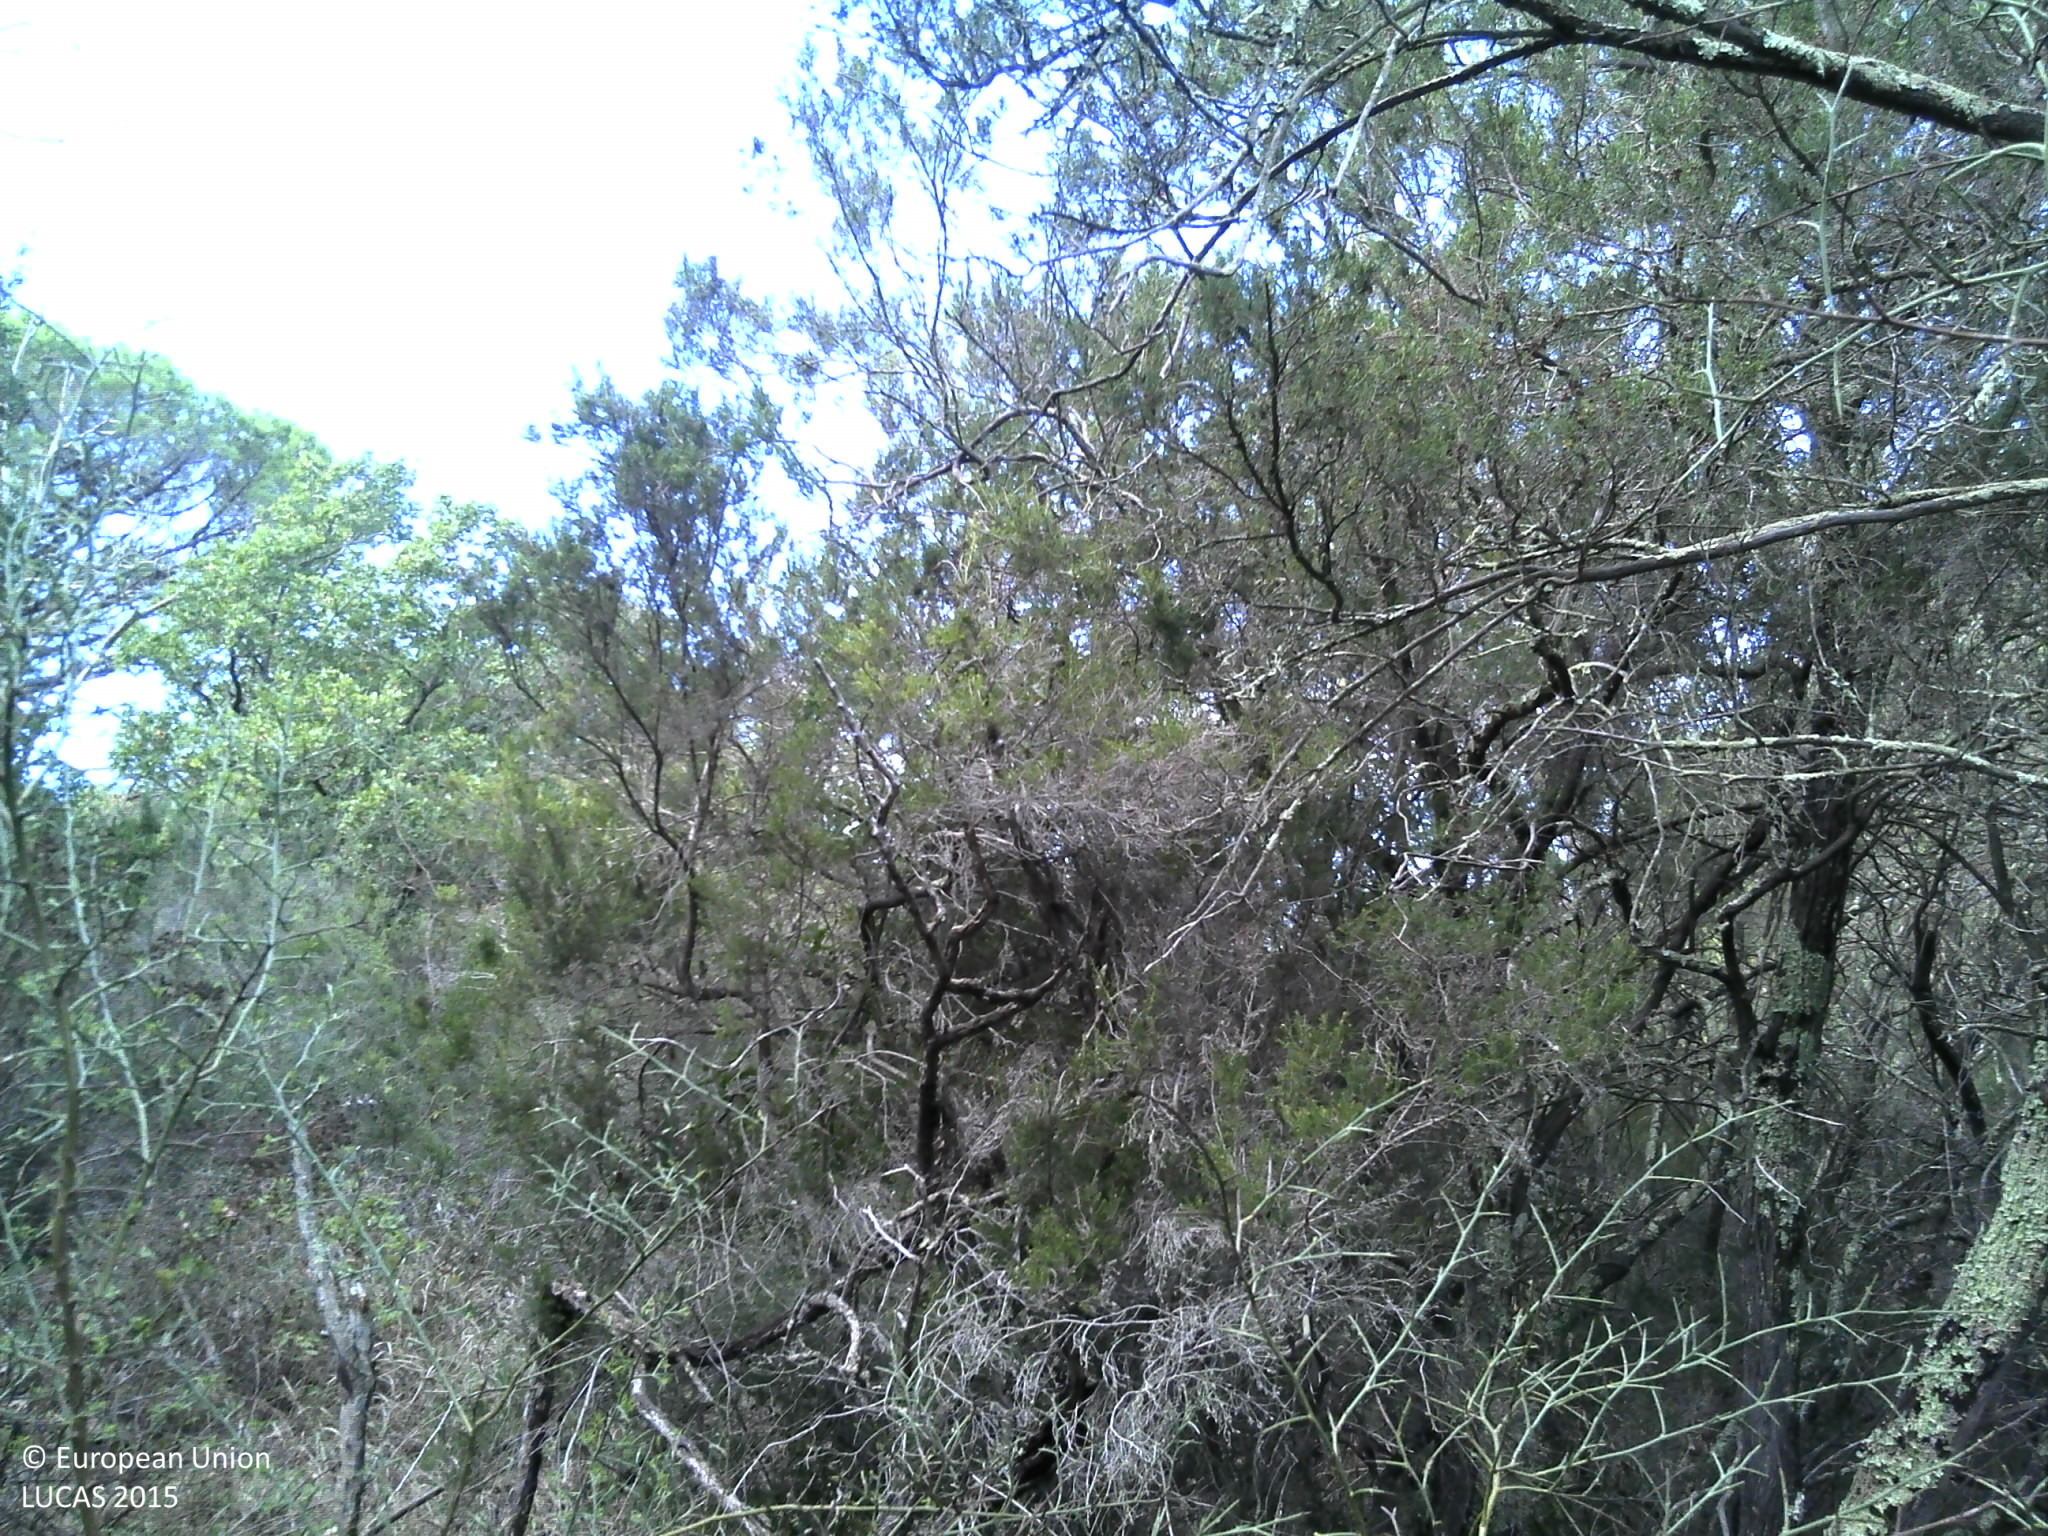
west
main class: Woodland
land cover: Pine dominated mixed woodland
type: broadleaved evergreen forest
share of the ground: > 75 %
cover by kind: broadleaved forest trees 50 %, coniferous forest trees 25 %, shrubs 25 %
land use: Semi-natural and natural areas not in use
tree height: > 5 m
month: October
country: FR
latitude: 43.1941
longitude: 6.6249
